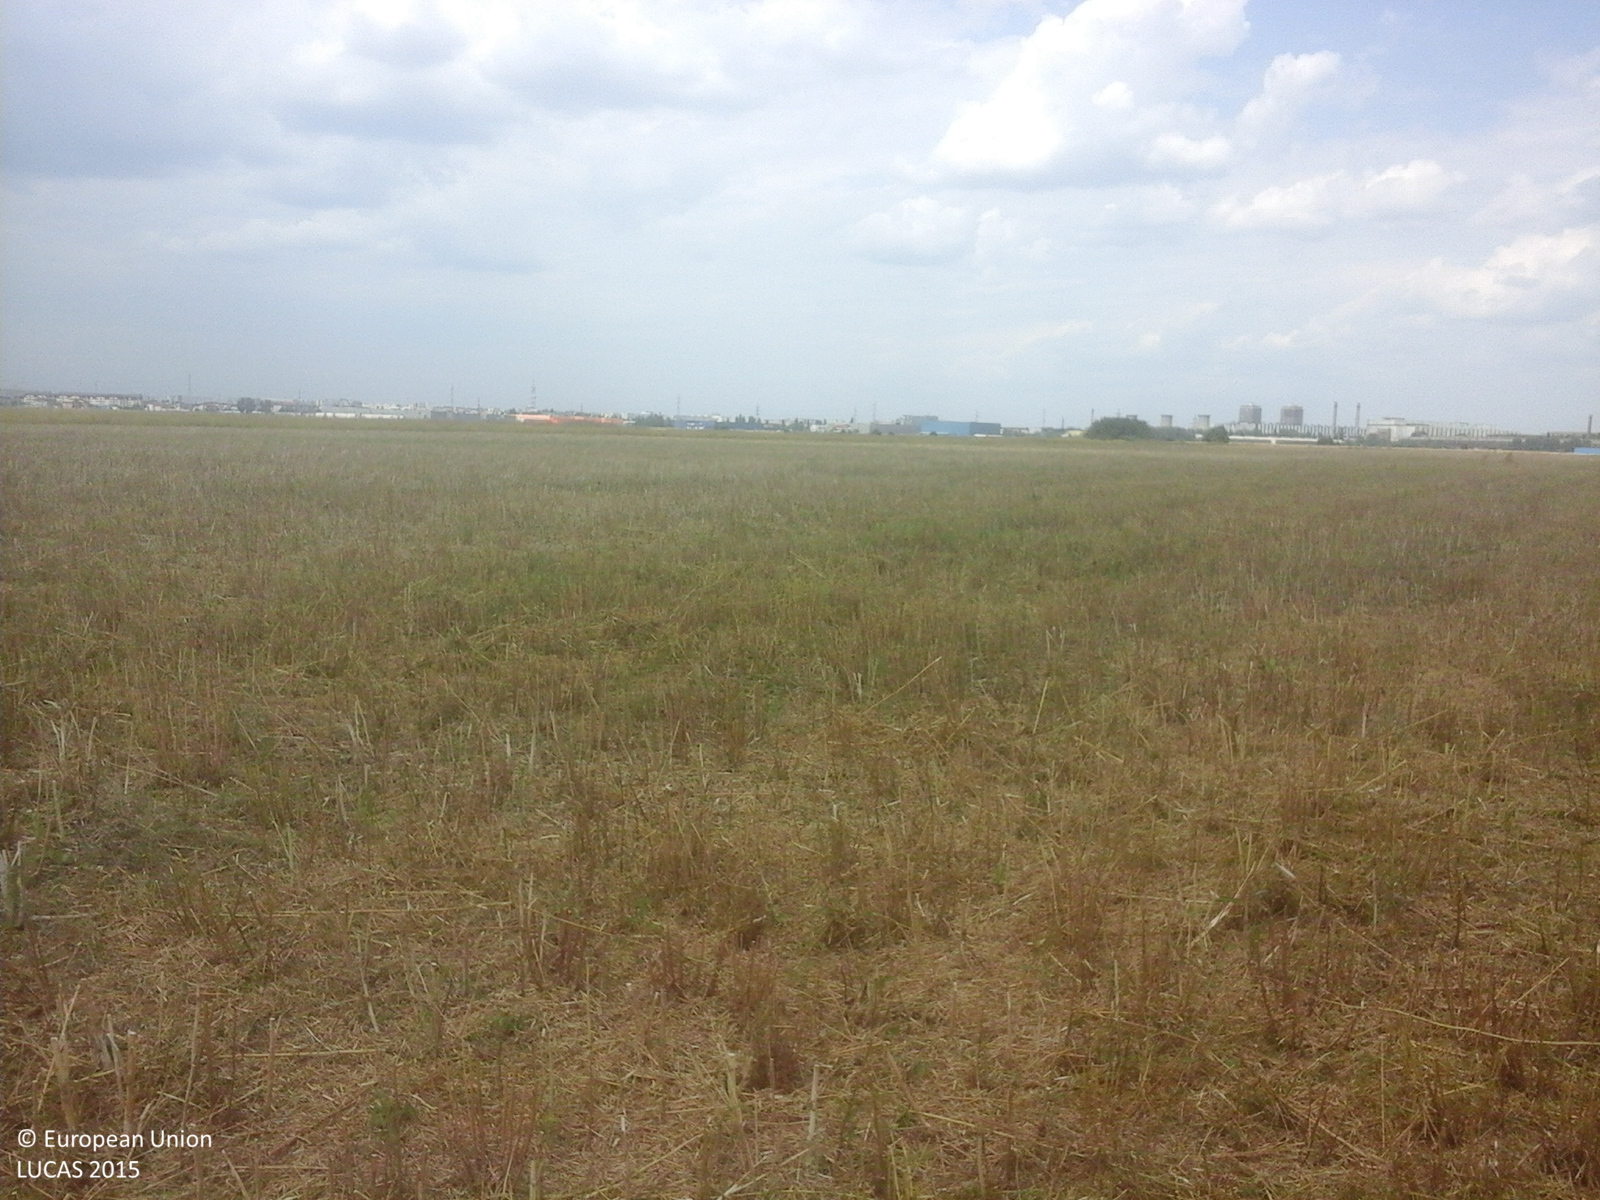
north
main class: Cropland
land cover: Other leguminous and mixtures for fodder
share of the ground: > 75 %
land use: Agriculture (excluding fallow land and kitchen gardens)
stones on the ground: < 10 %
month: June
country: RO
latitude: 44.3467
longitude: 26.1236
